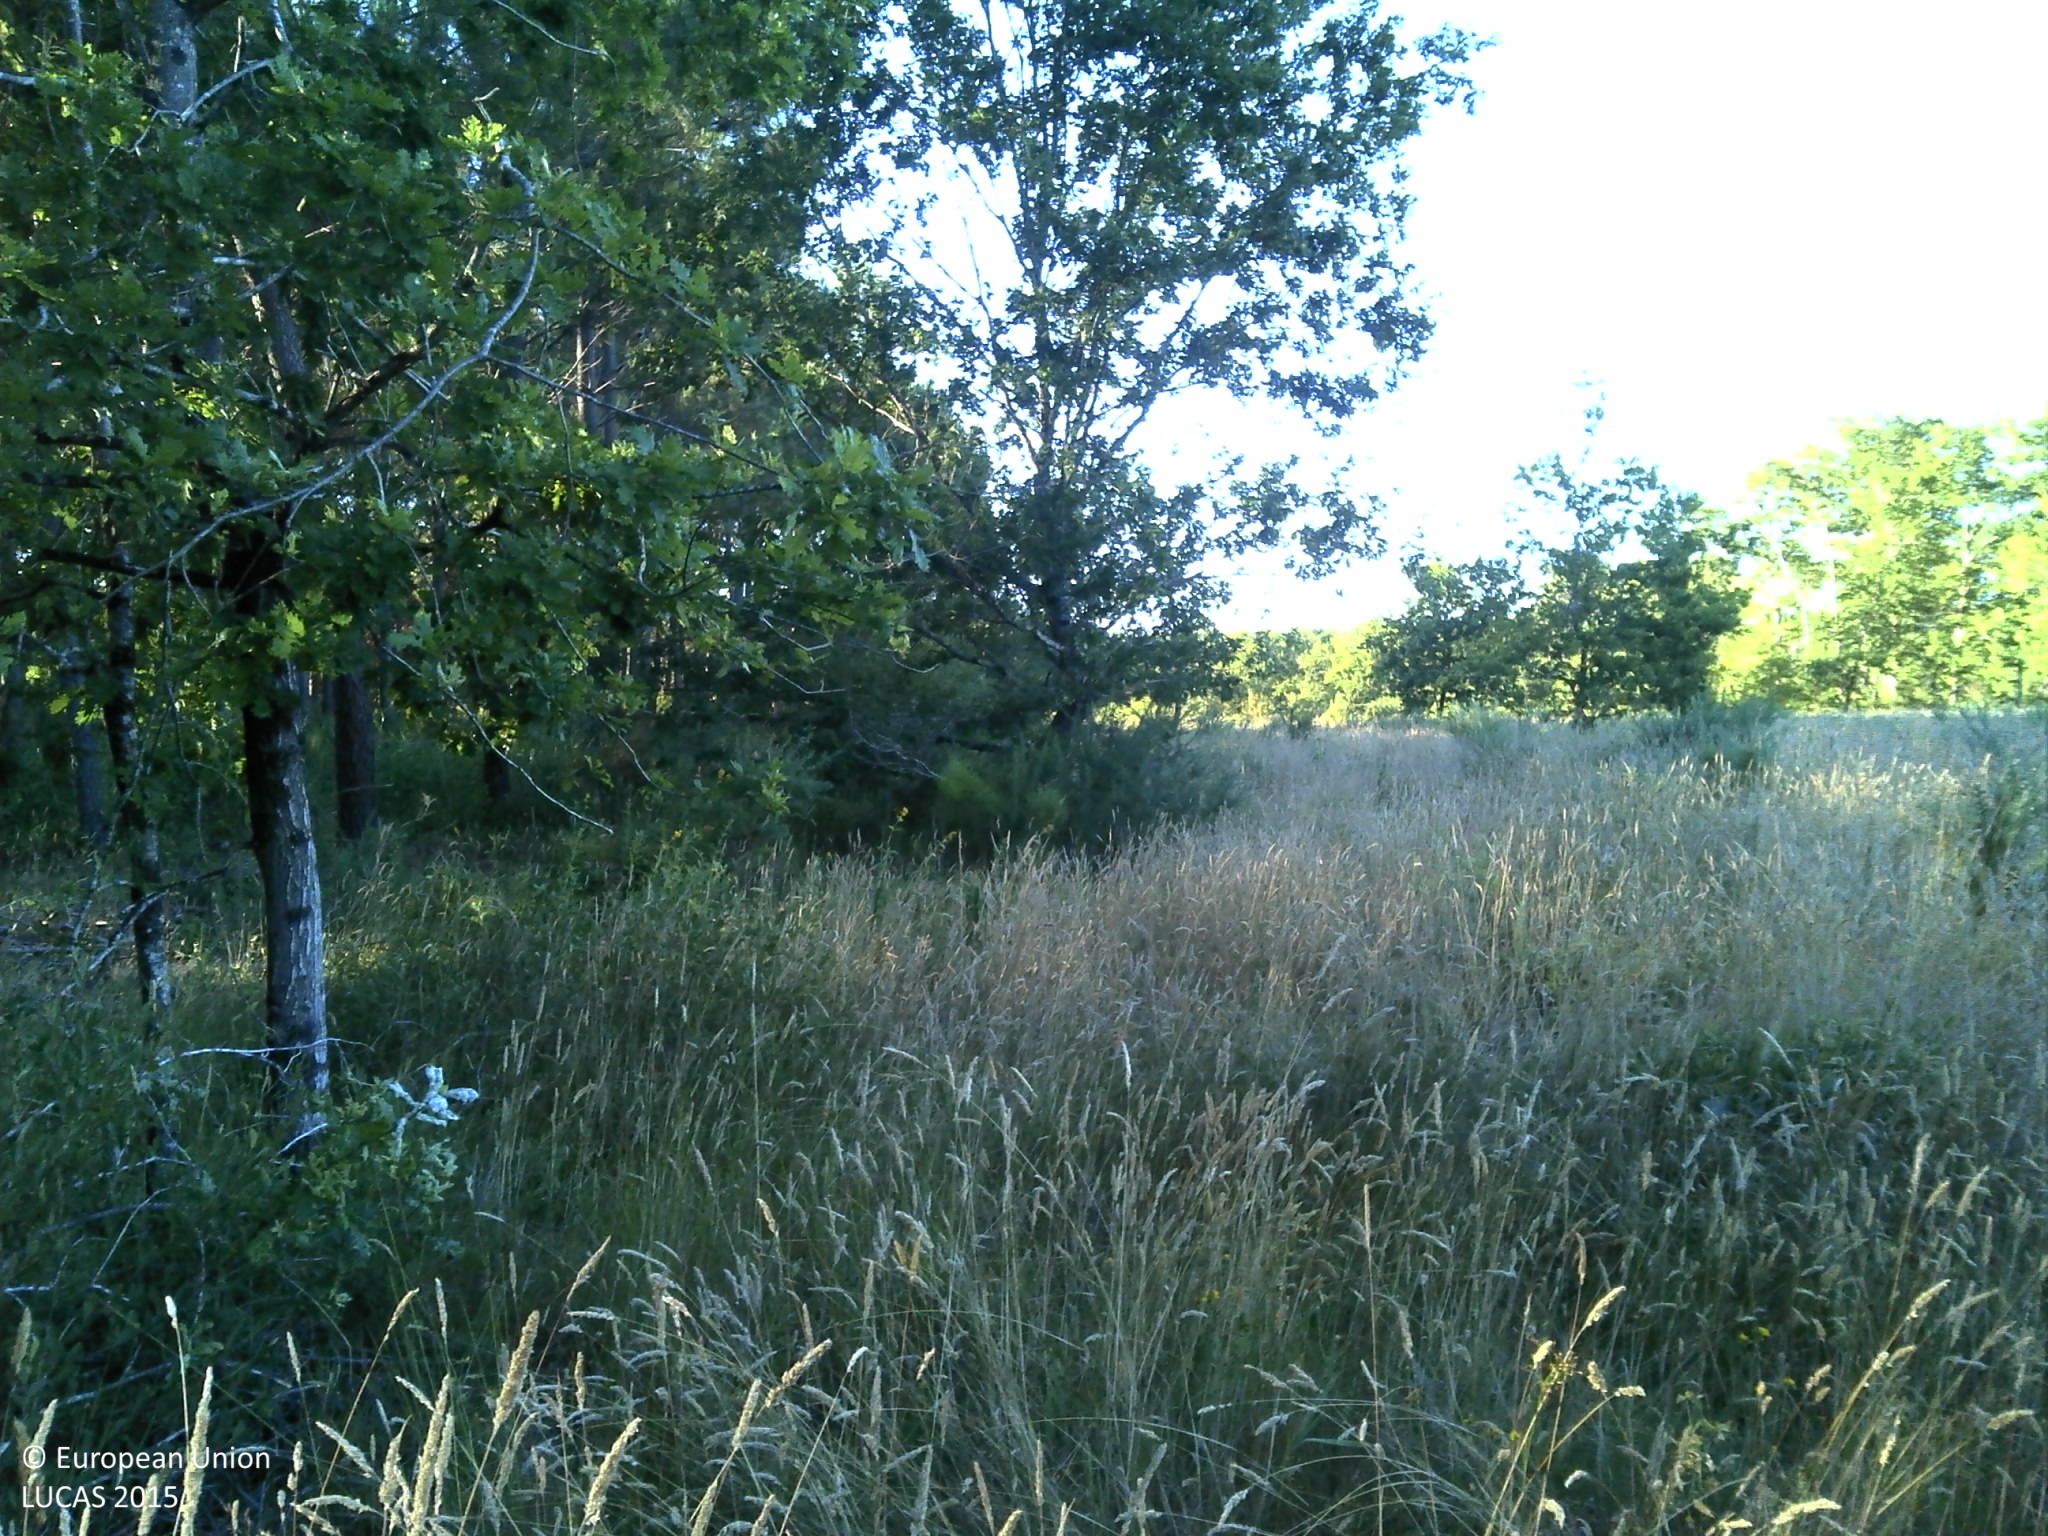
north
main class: Woodland
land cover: Pine dominated mixed woodland
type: exotic forest
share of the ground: > 75 %
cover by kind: coniferous forest trees 65 %, broadleaved forest trees 25 %, herbaceous plants 10 %
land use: Forestry
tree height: > 5 m
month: July
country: FR
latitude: 45.3391
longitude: -1.0650
